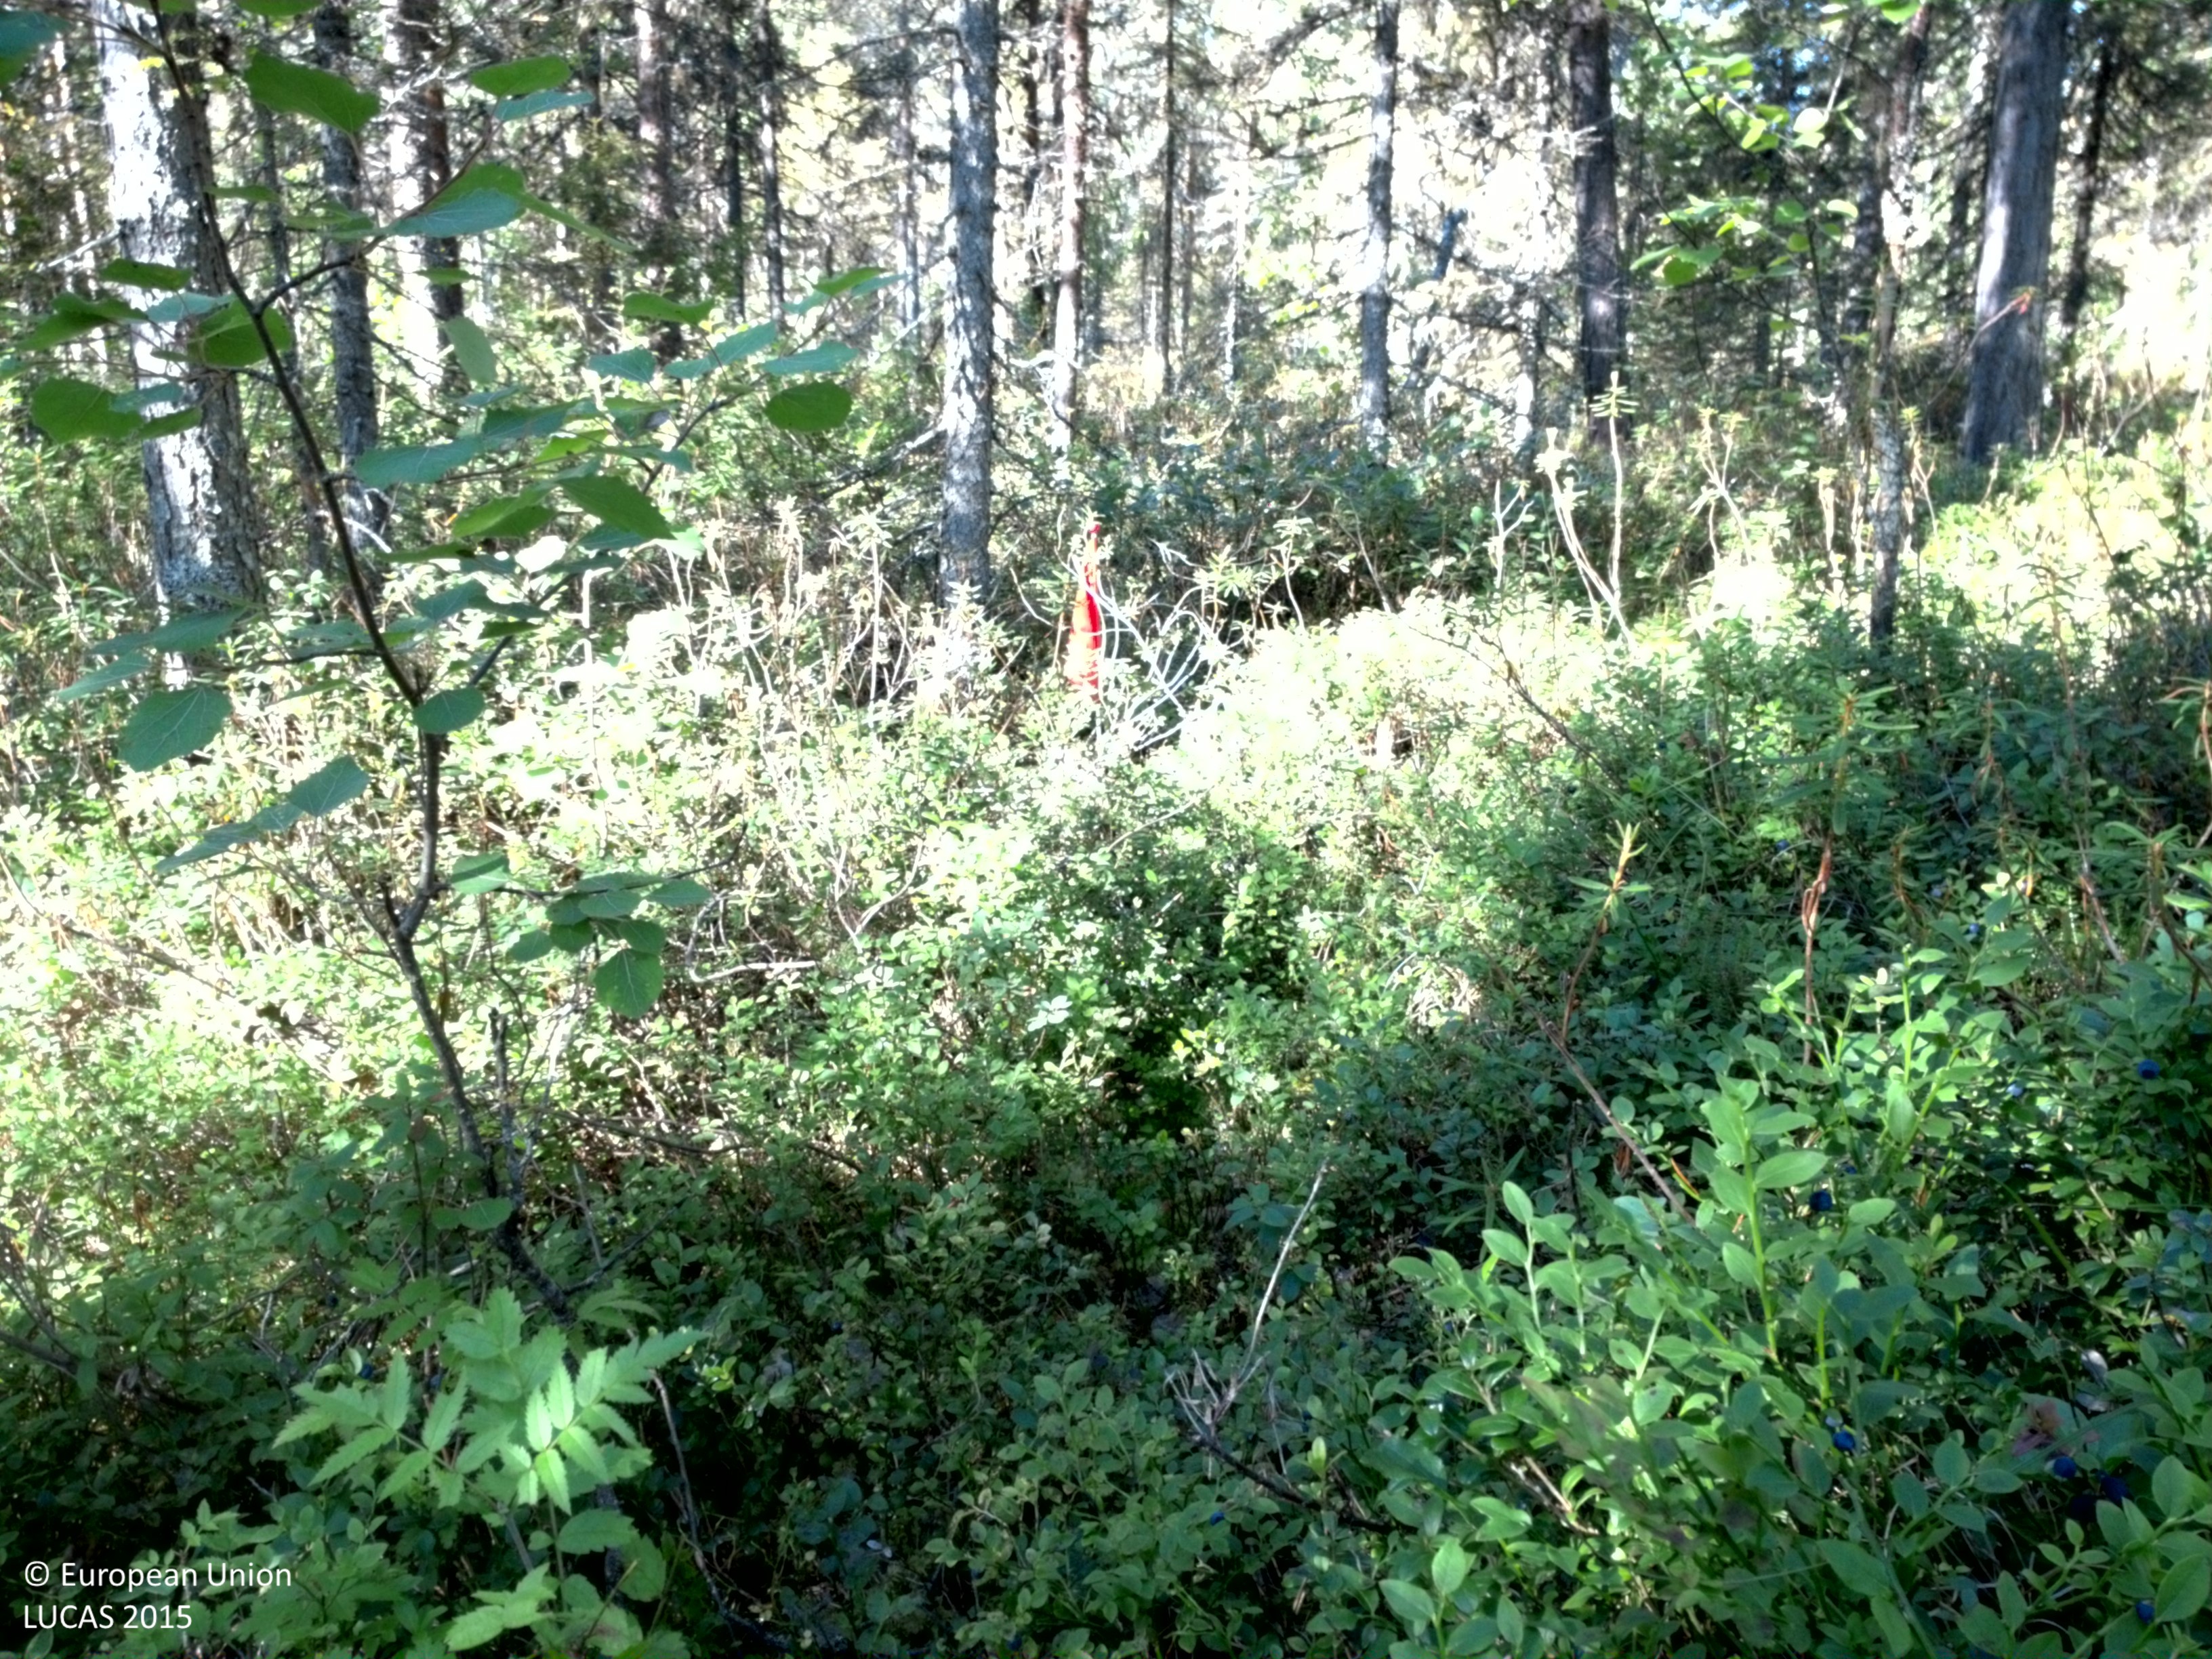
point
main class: Woodland
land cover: Pine dominated coniferous woodland
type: boreal forest
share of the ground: 25 - 50 %
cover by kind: shrubs 60 %, coniferous forest trees 35 %, broadleaved forest trees 5 %
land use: Forestry
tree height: > 5 m
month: August
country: SE
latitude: 66.2342
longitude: 20.6114
